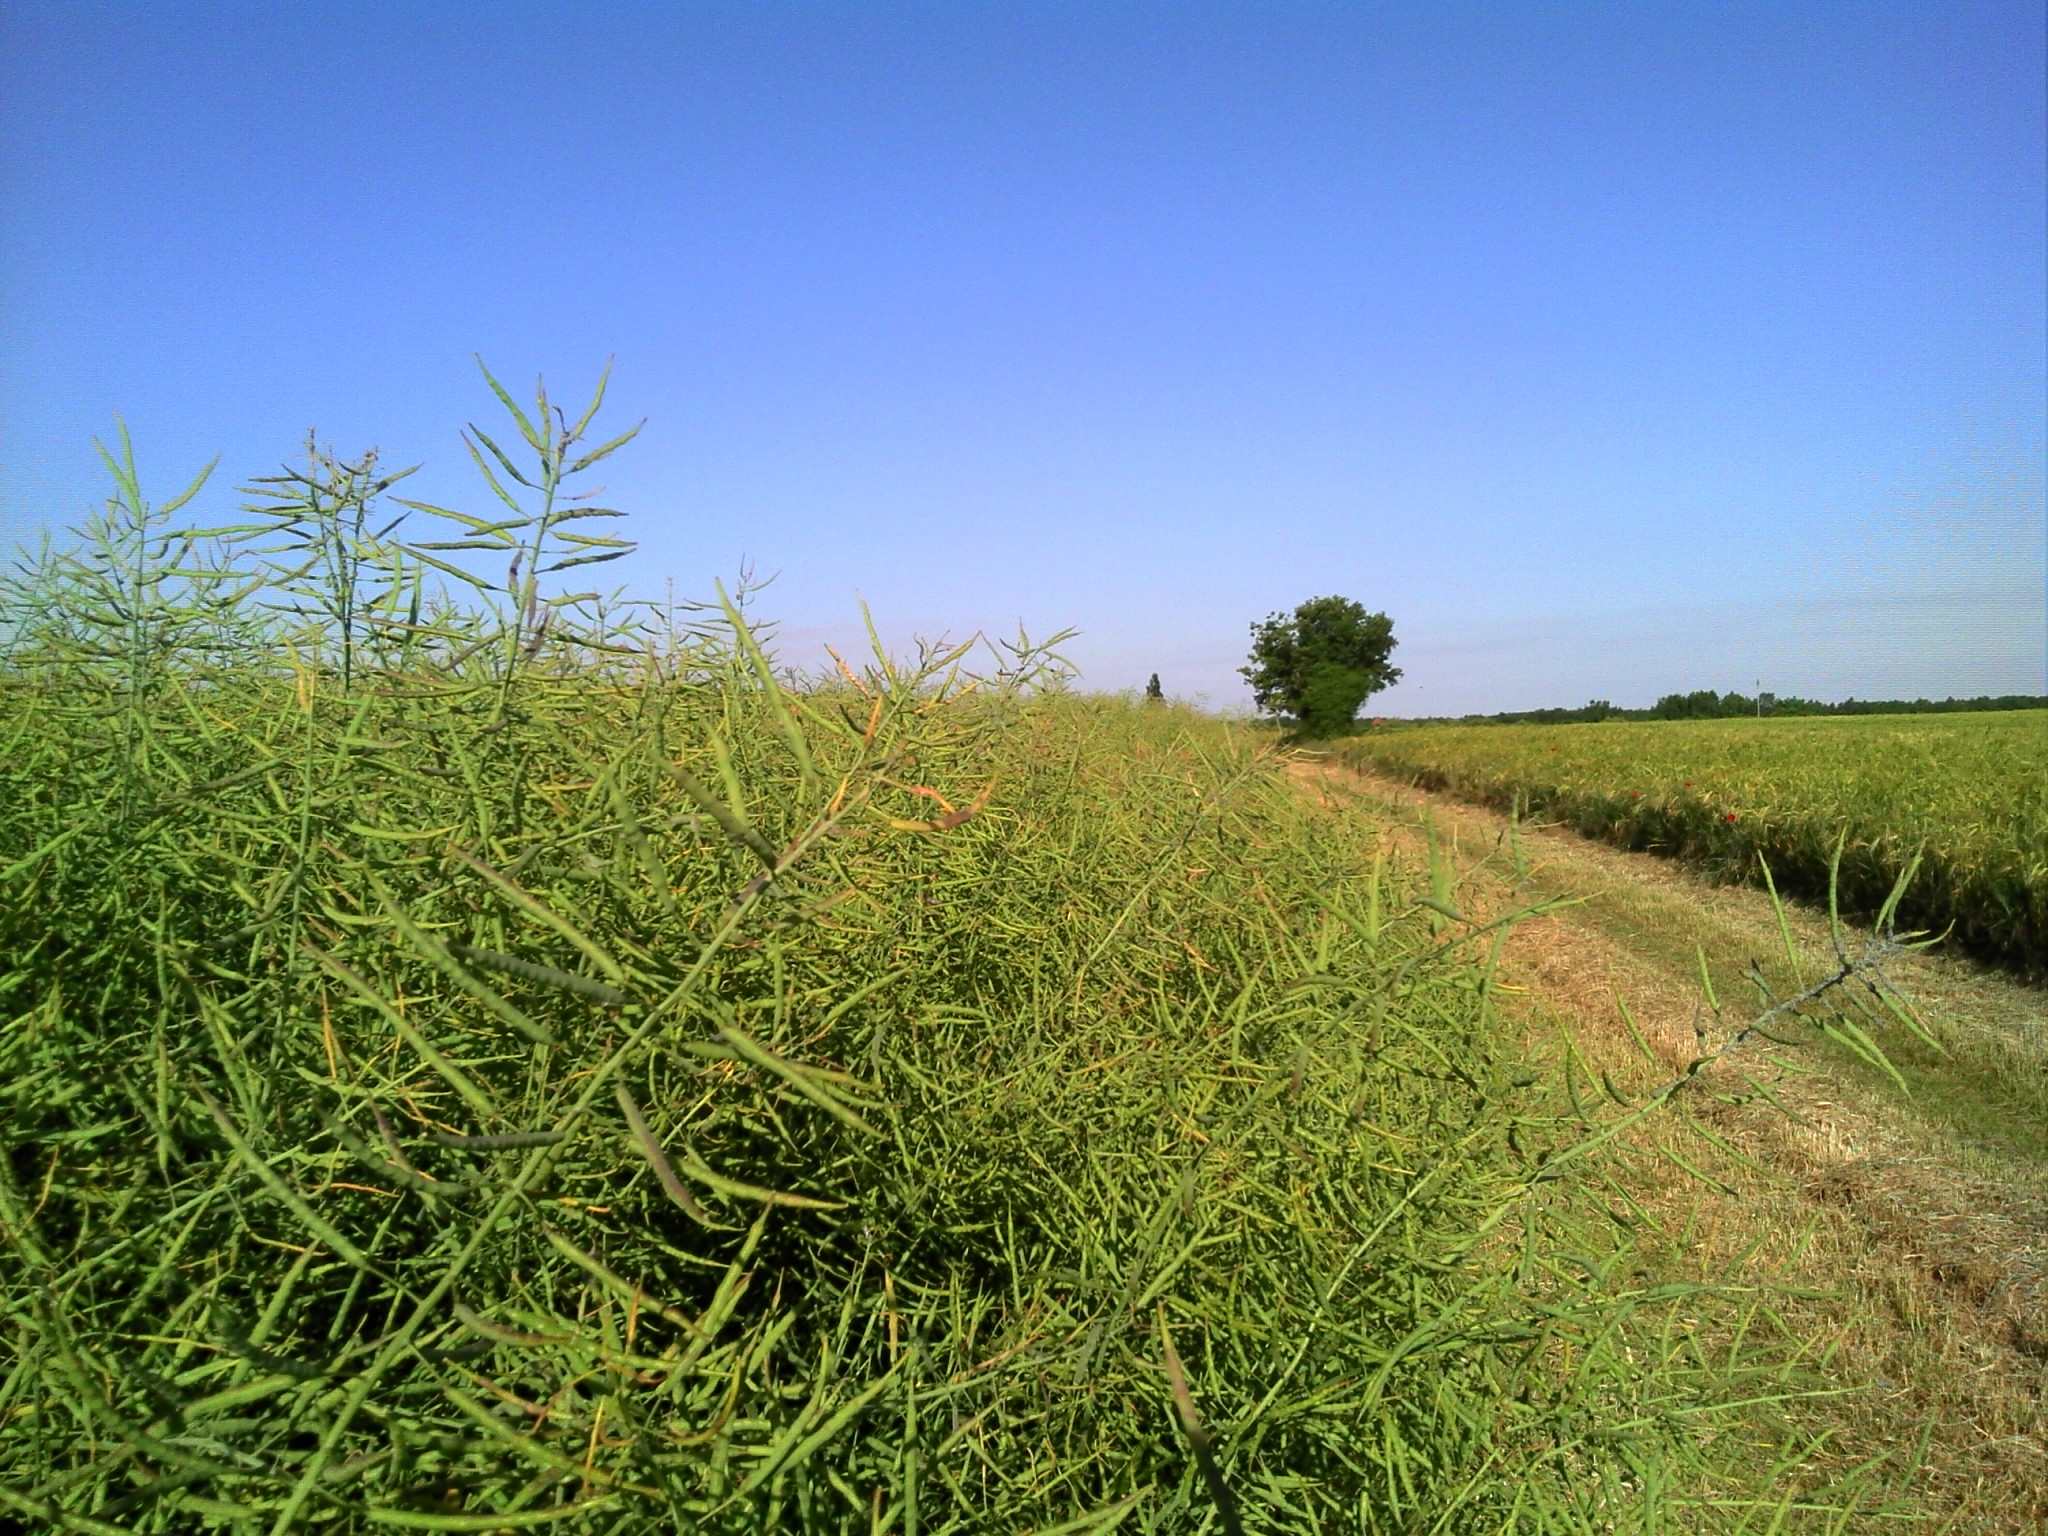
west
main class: Cropland
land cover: Rape and turnip rape
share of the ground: > 75 %
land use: Agriculture (excluding fallow land and kitchen gardens)
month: May
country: FR
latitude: 47.0580
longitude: 0.1692
